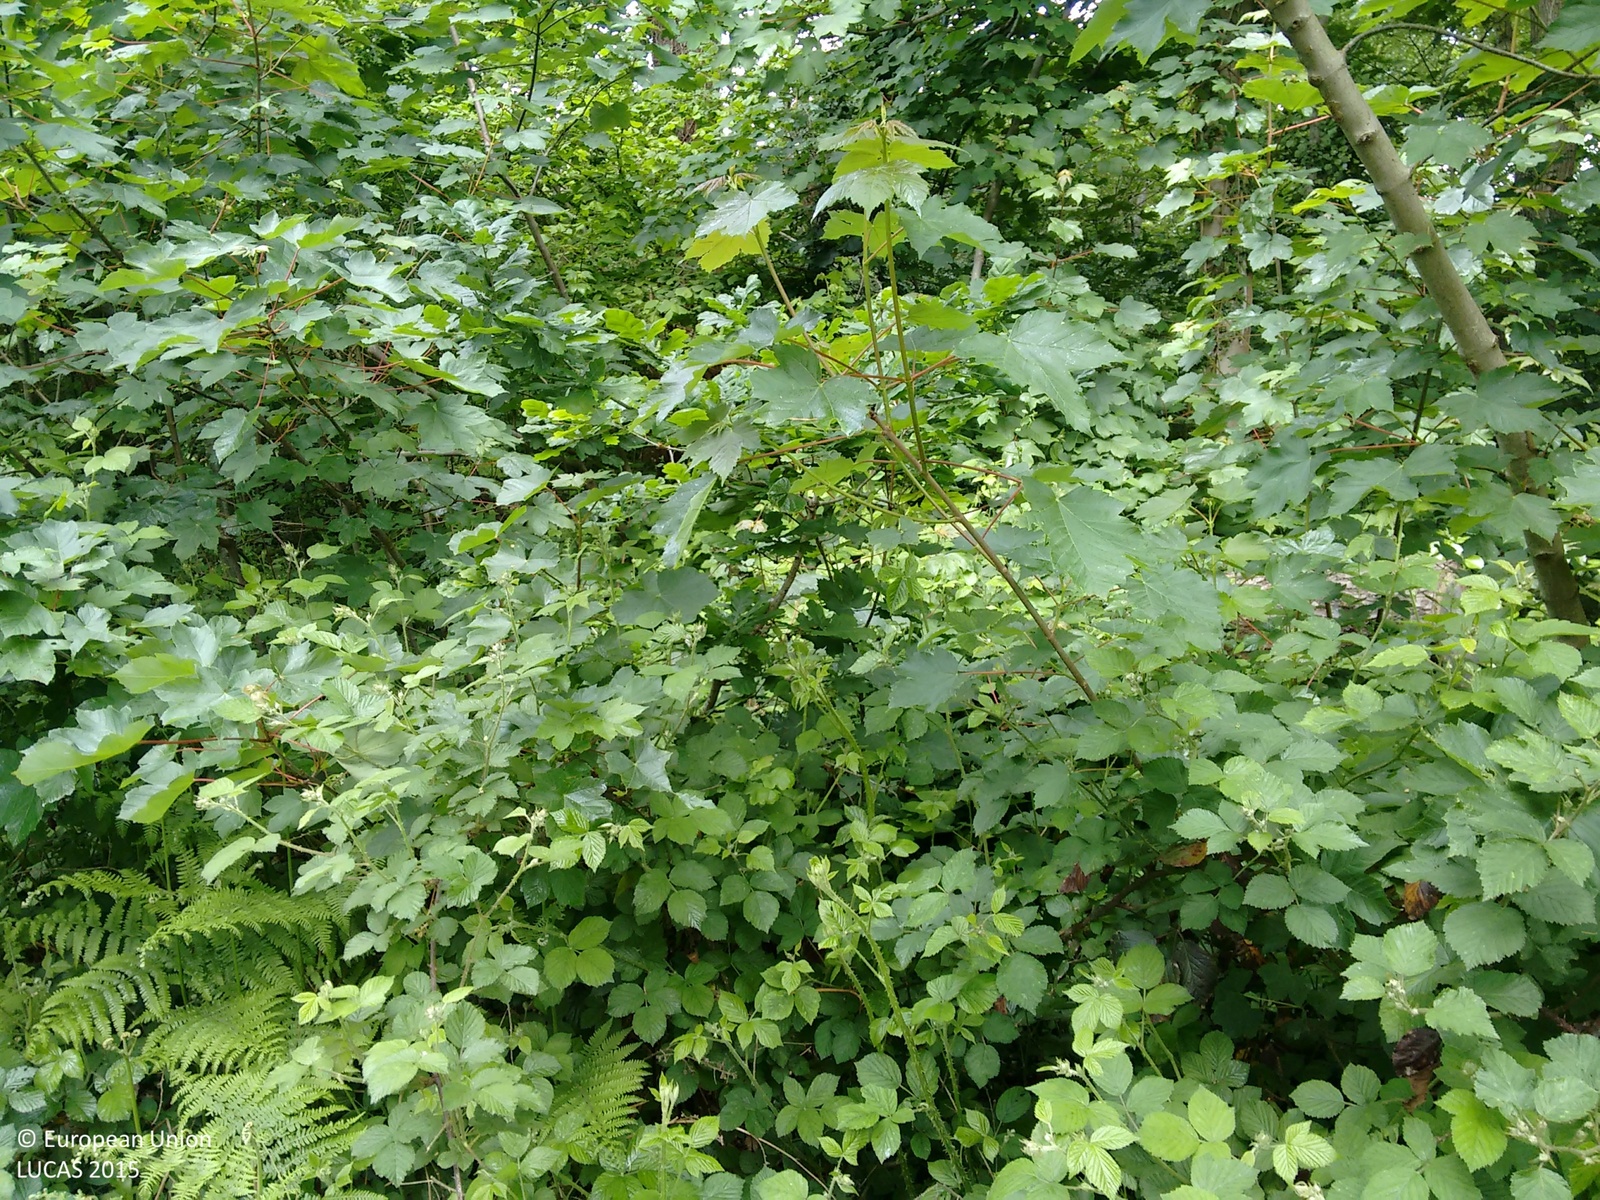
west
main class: Woodland
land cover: Broadleaved woodland
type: mesophytic deciduous forest
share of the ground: > 75 %
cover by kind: broadleaved forest trees 90 %, coniferous forest trees 10 %
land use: Forestry
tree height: > 5 m
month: May
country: GB
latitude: 50.8718
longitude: -0.9430
